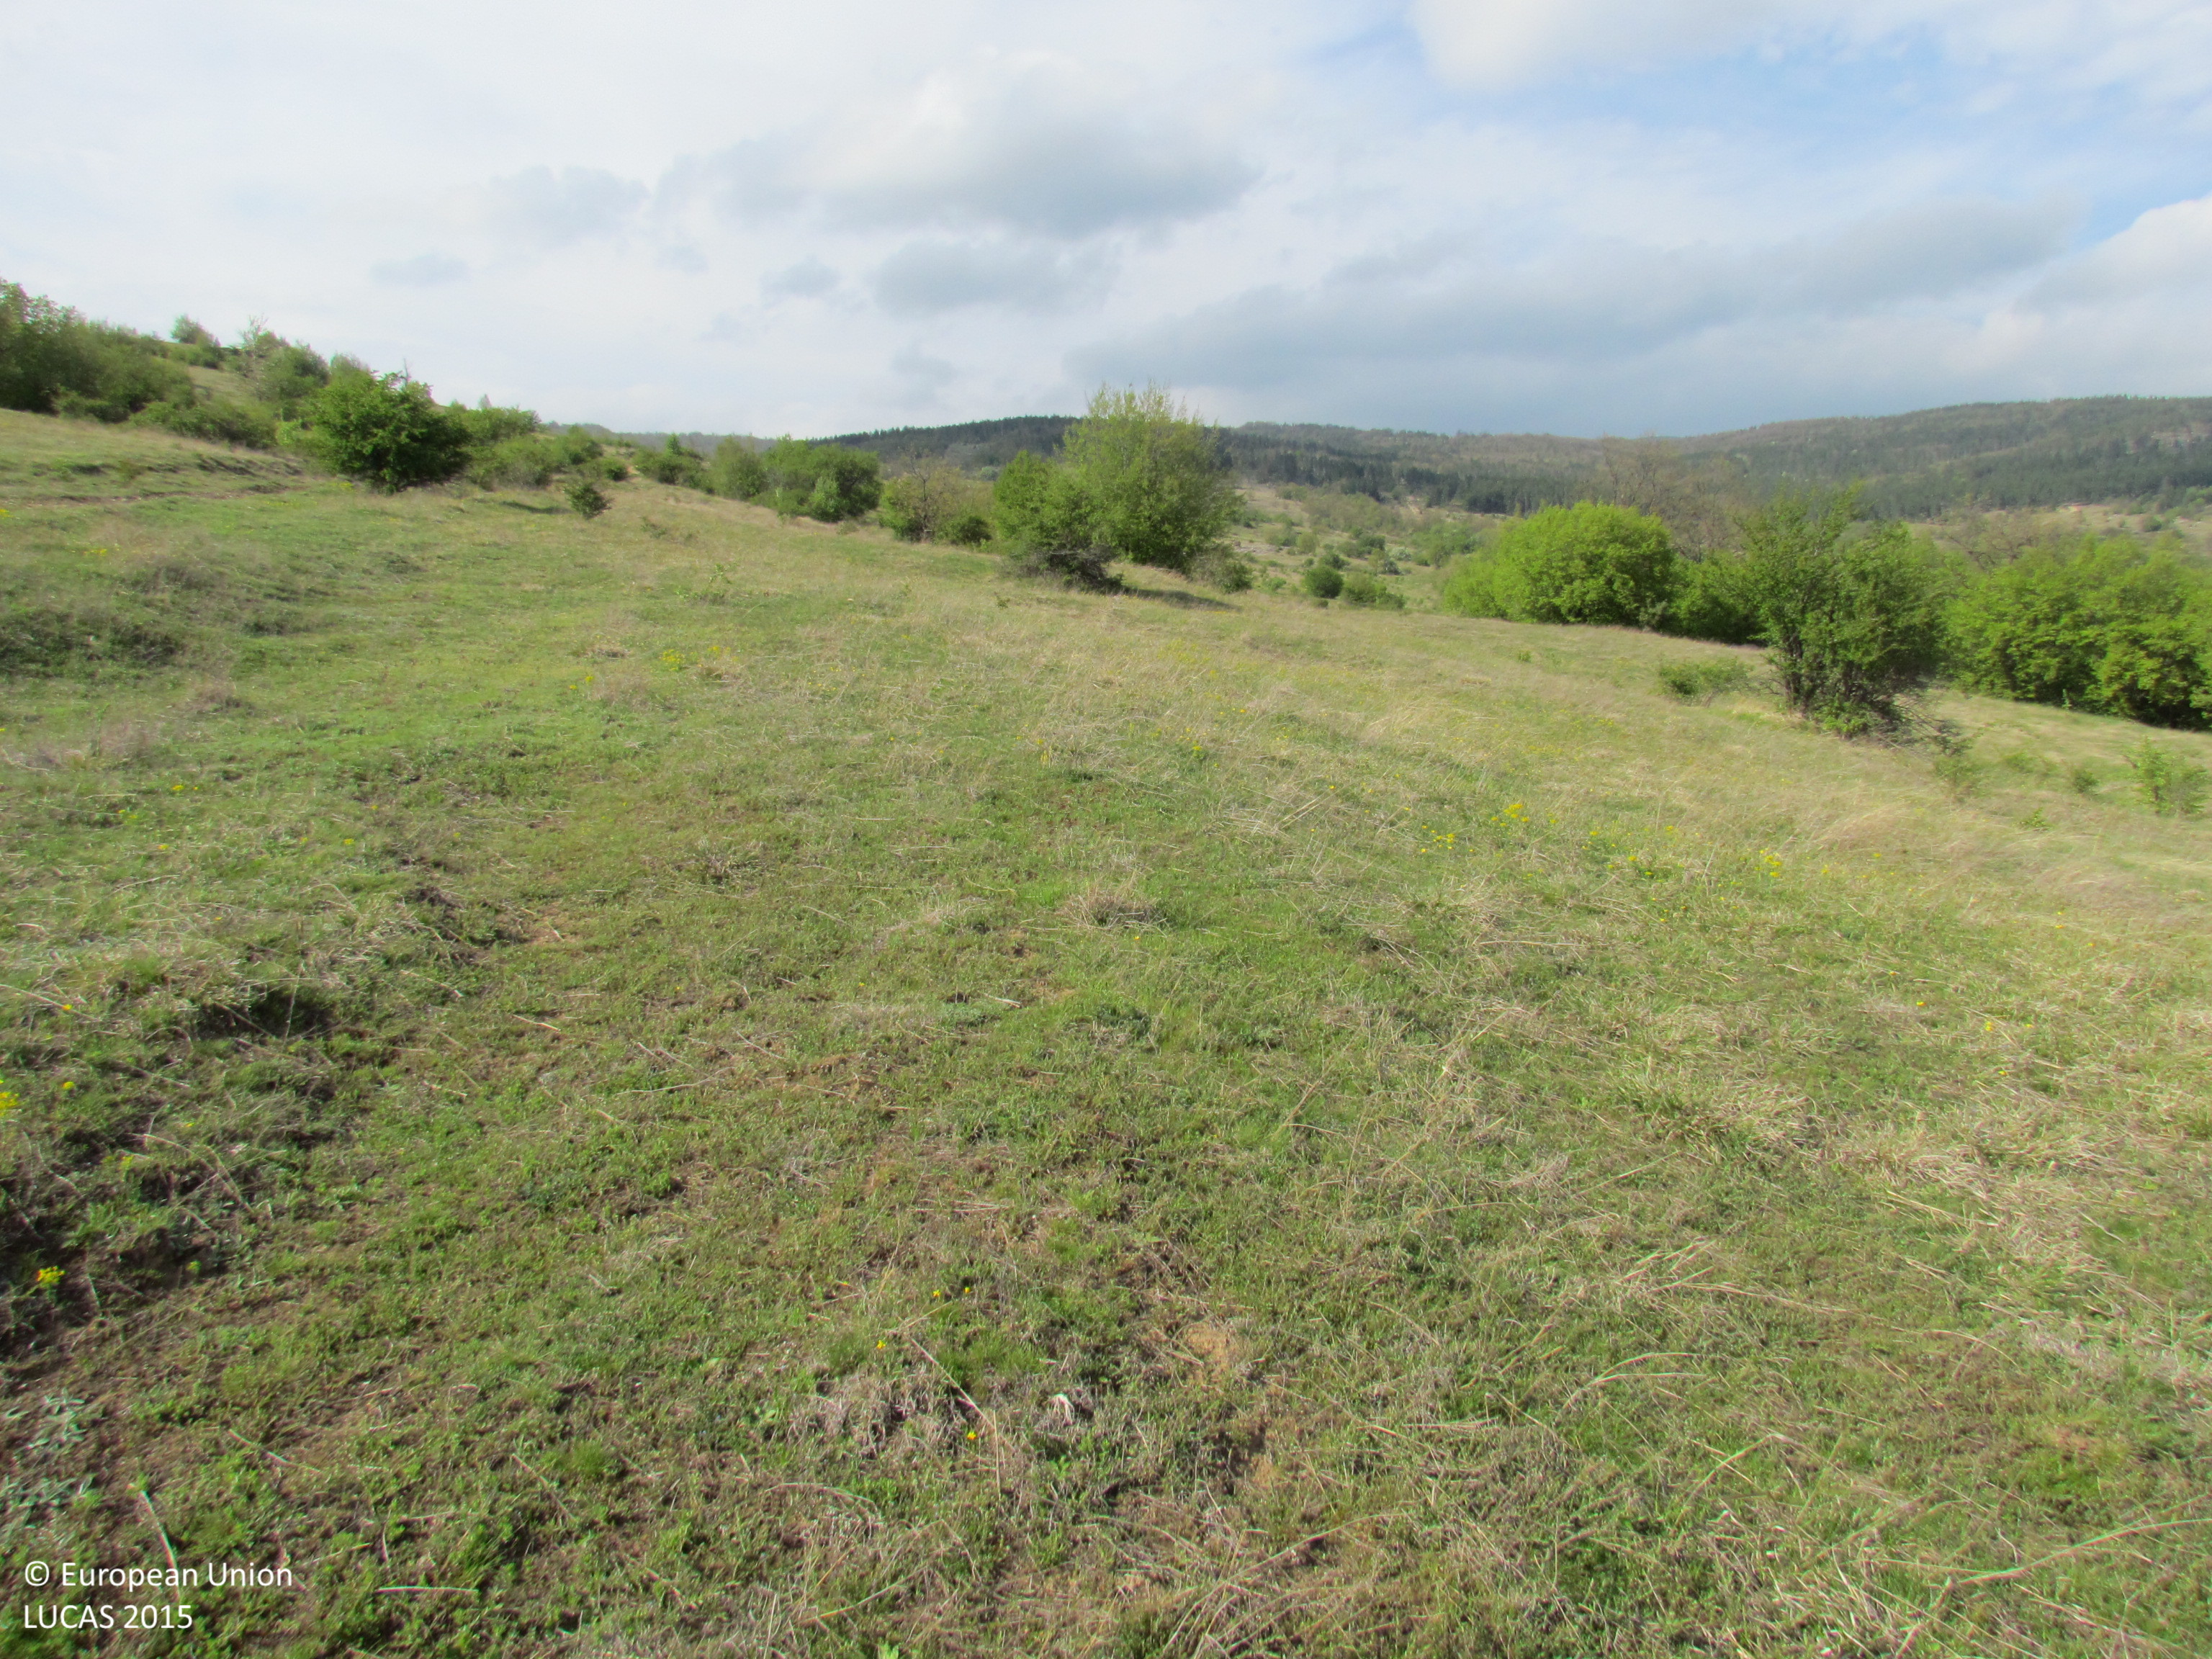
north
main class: Grassland
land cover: Grassland without tree/shrub cover
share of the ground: > 75 %
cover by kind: herbaceous plants 100 %
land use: Agriculture (excluding fallow land and kitchen gardens)
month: April
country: BG
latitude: 42.8824
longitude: 26.7670
